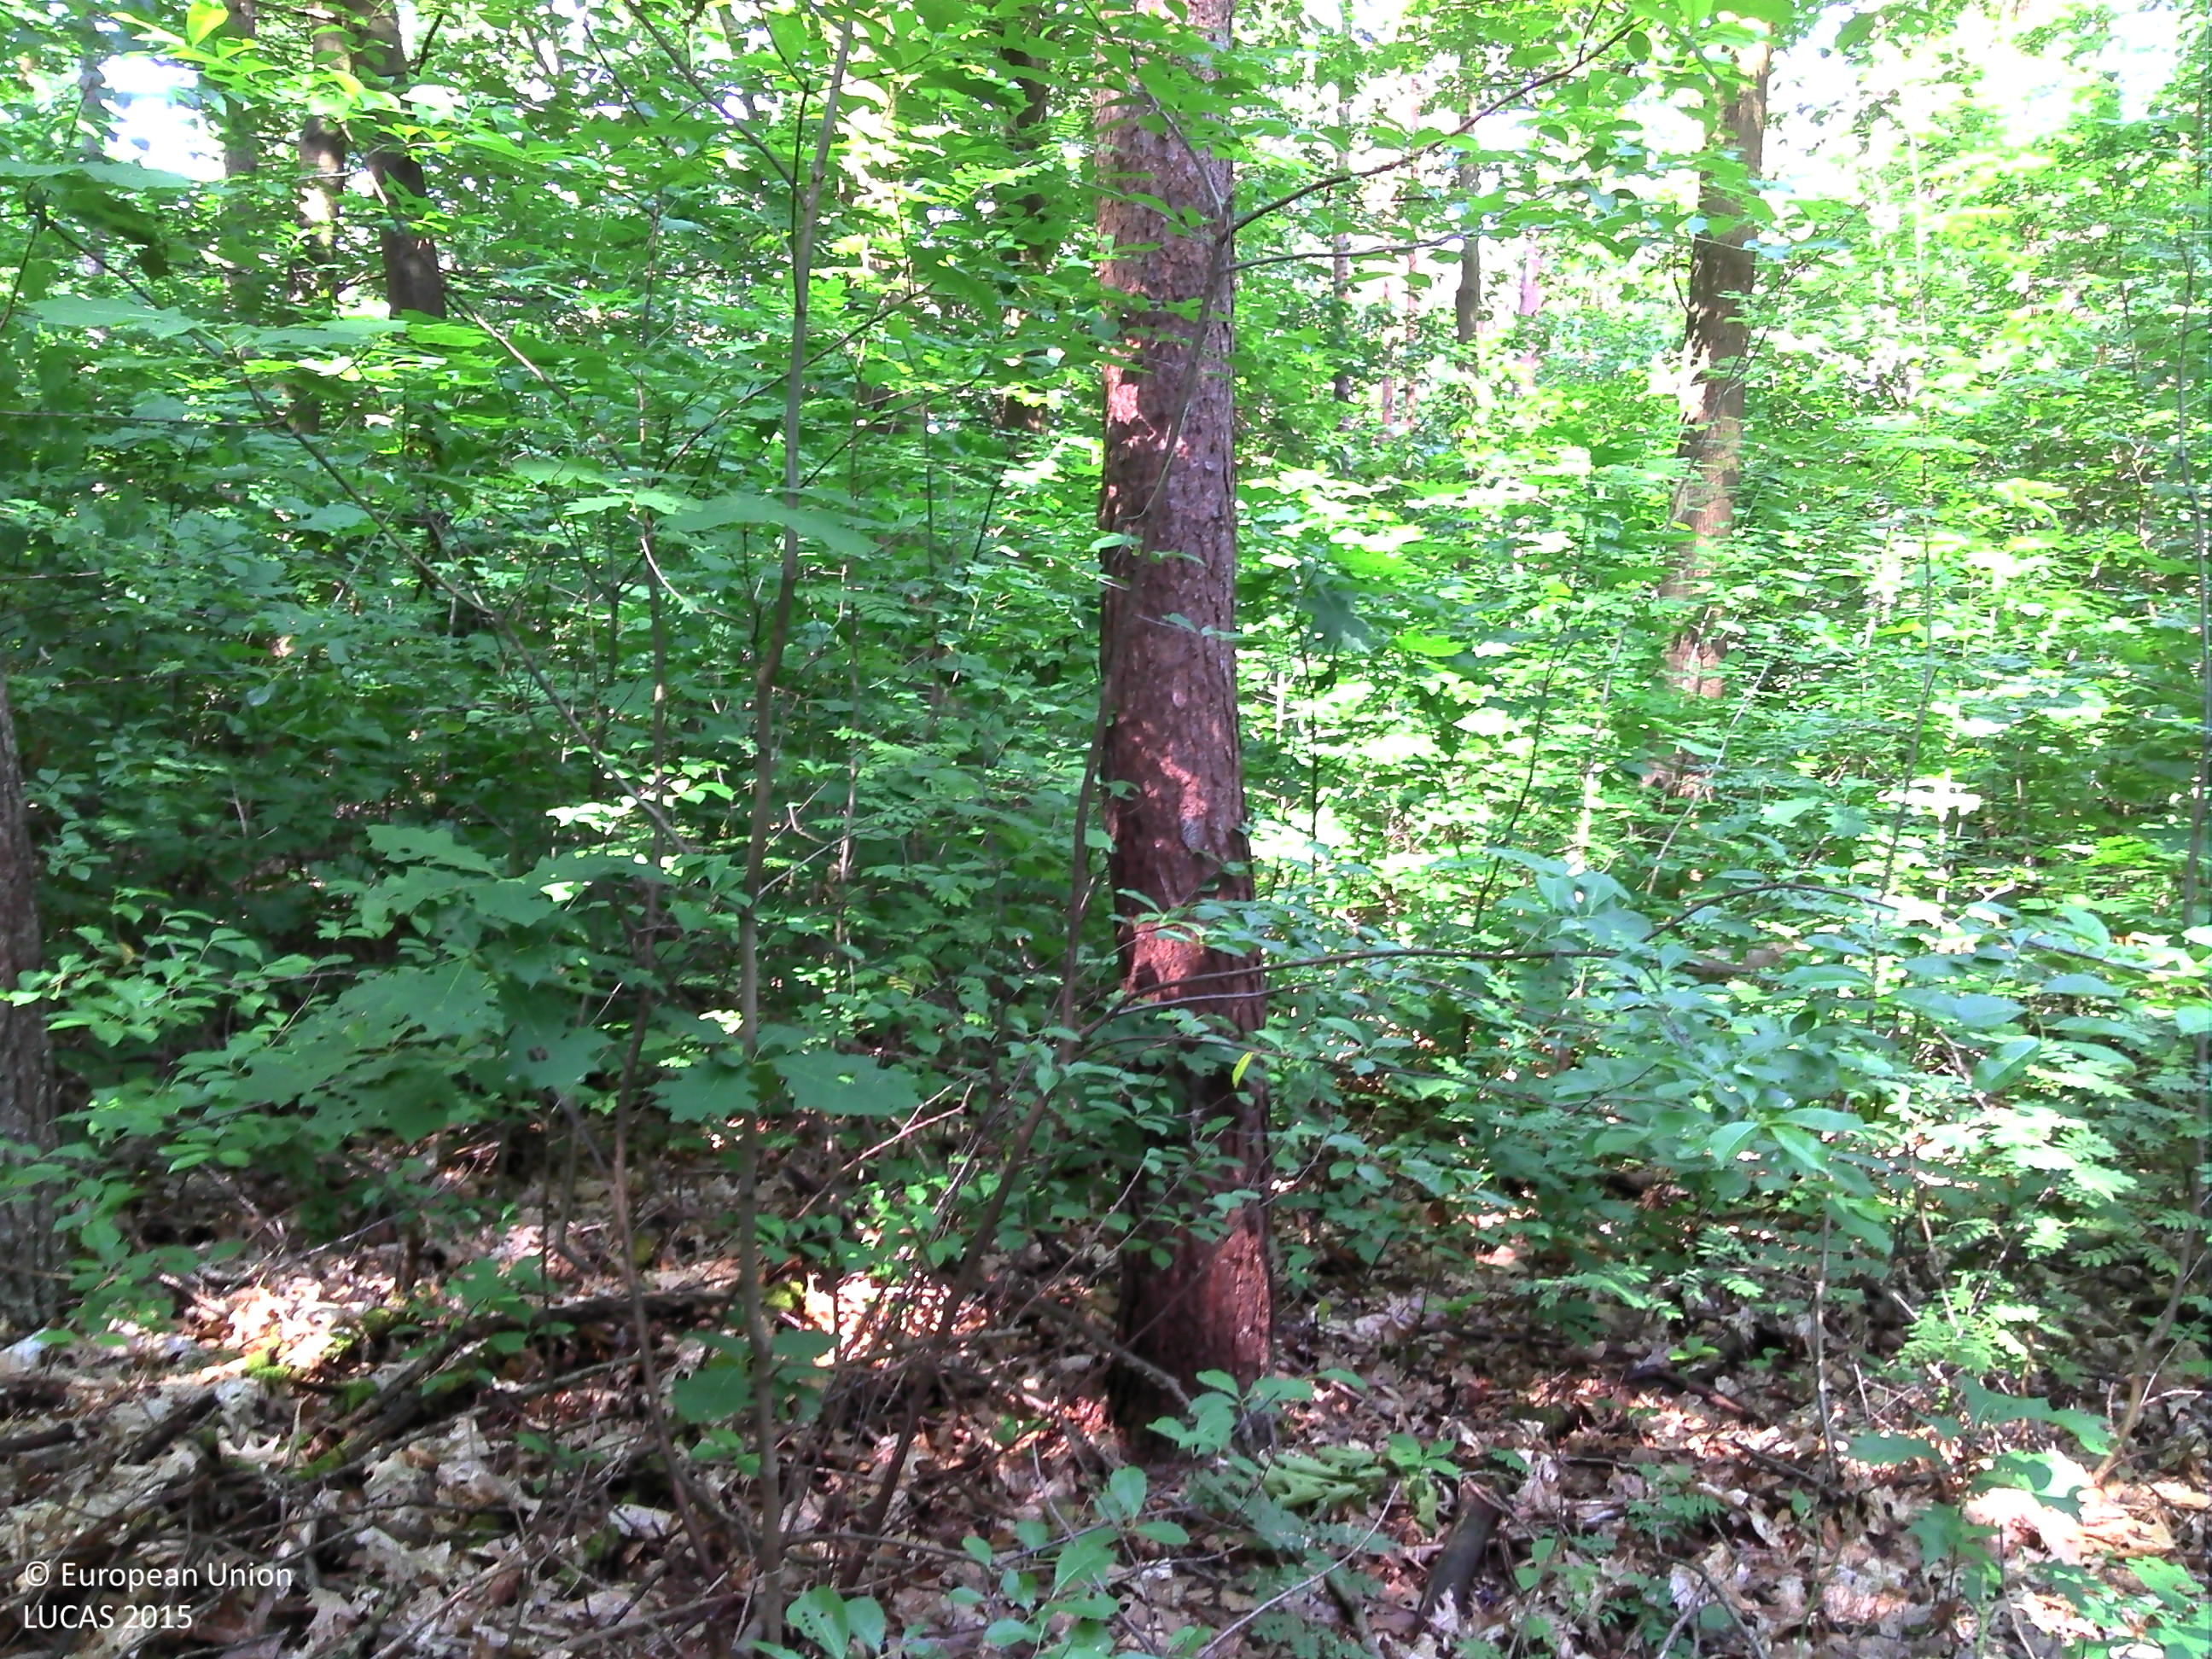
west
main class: Woodland
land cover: Pine dominated mixed woodland
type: exotic forest
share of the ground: > 75 %
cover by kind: coniferous forest trees 50 %, broadleaved forest trees 40 %, herbaceous plants 10 %
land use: Forestry
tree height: > 5 m
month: June
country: BE
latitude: 50.9087
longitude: 5.5753
